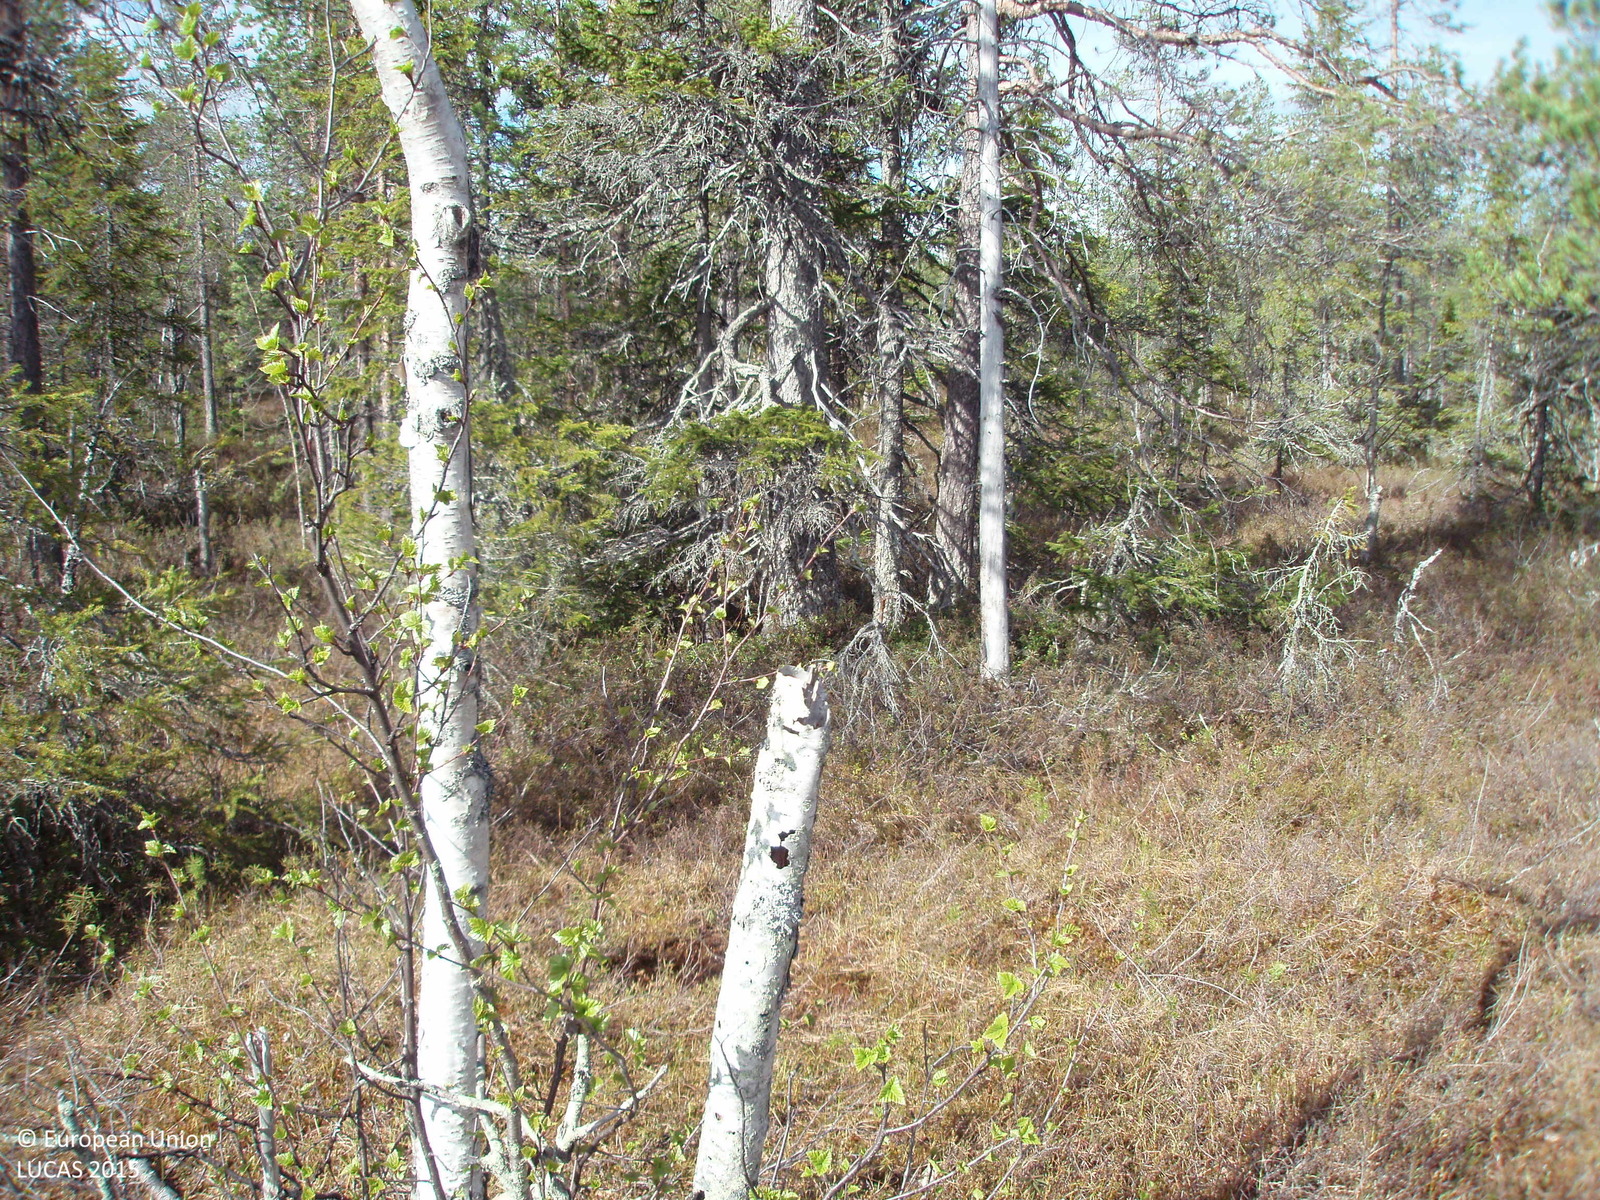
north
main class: Woodland
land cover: Pine dominated coniferous woodland
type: mire and swamp forests
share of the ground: 50 - 75 %
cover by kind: coniferous forest trees 50 %, shrubs 25 %, herbaceous plants 20 %, broadleaved forest trees 5 %
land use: Forestry
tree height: > 5 m
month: June
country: FI
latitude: 66.7227
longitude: 26.8507
